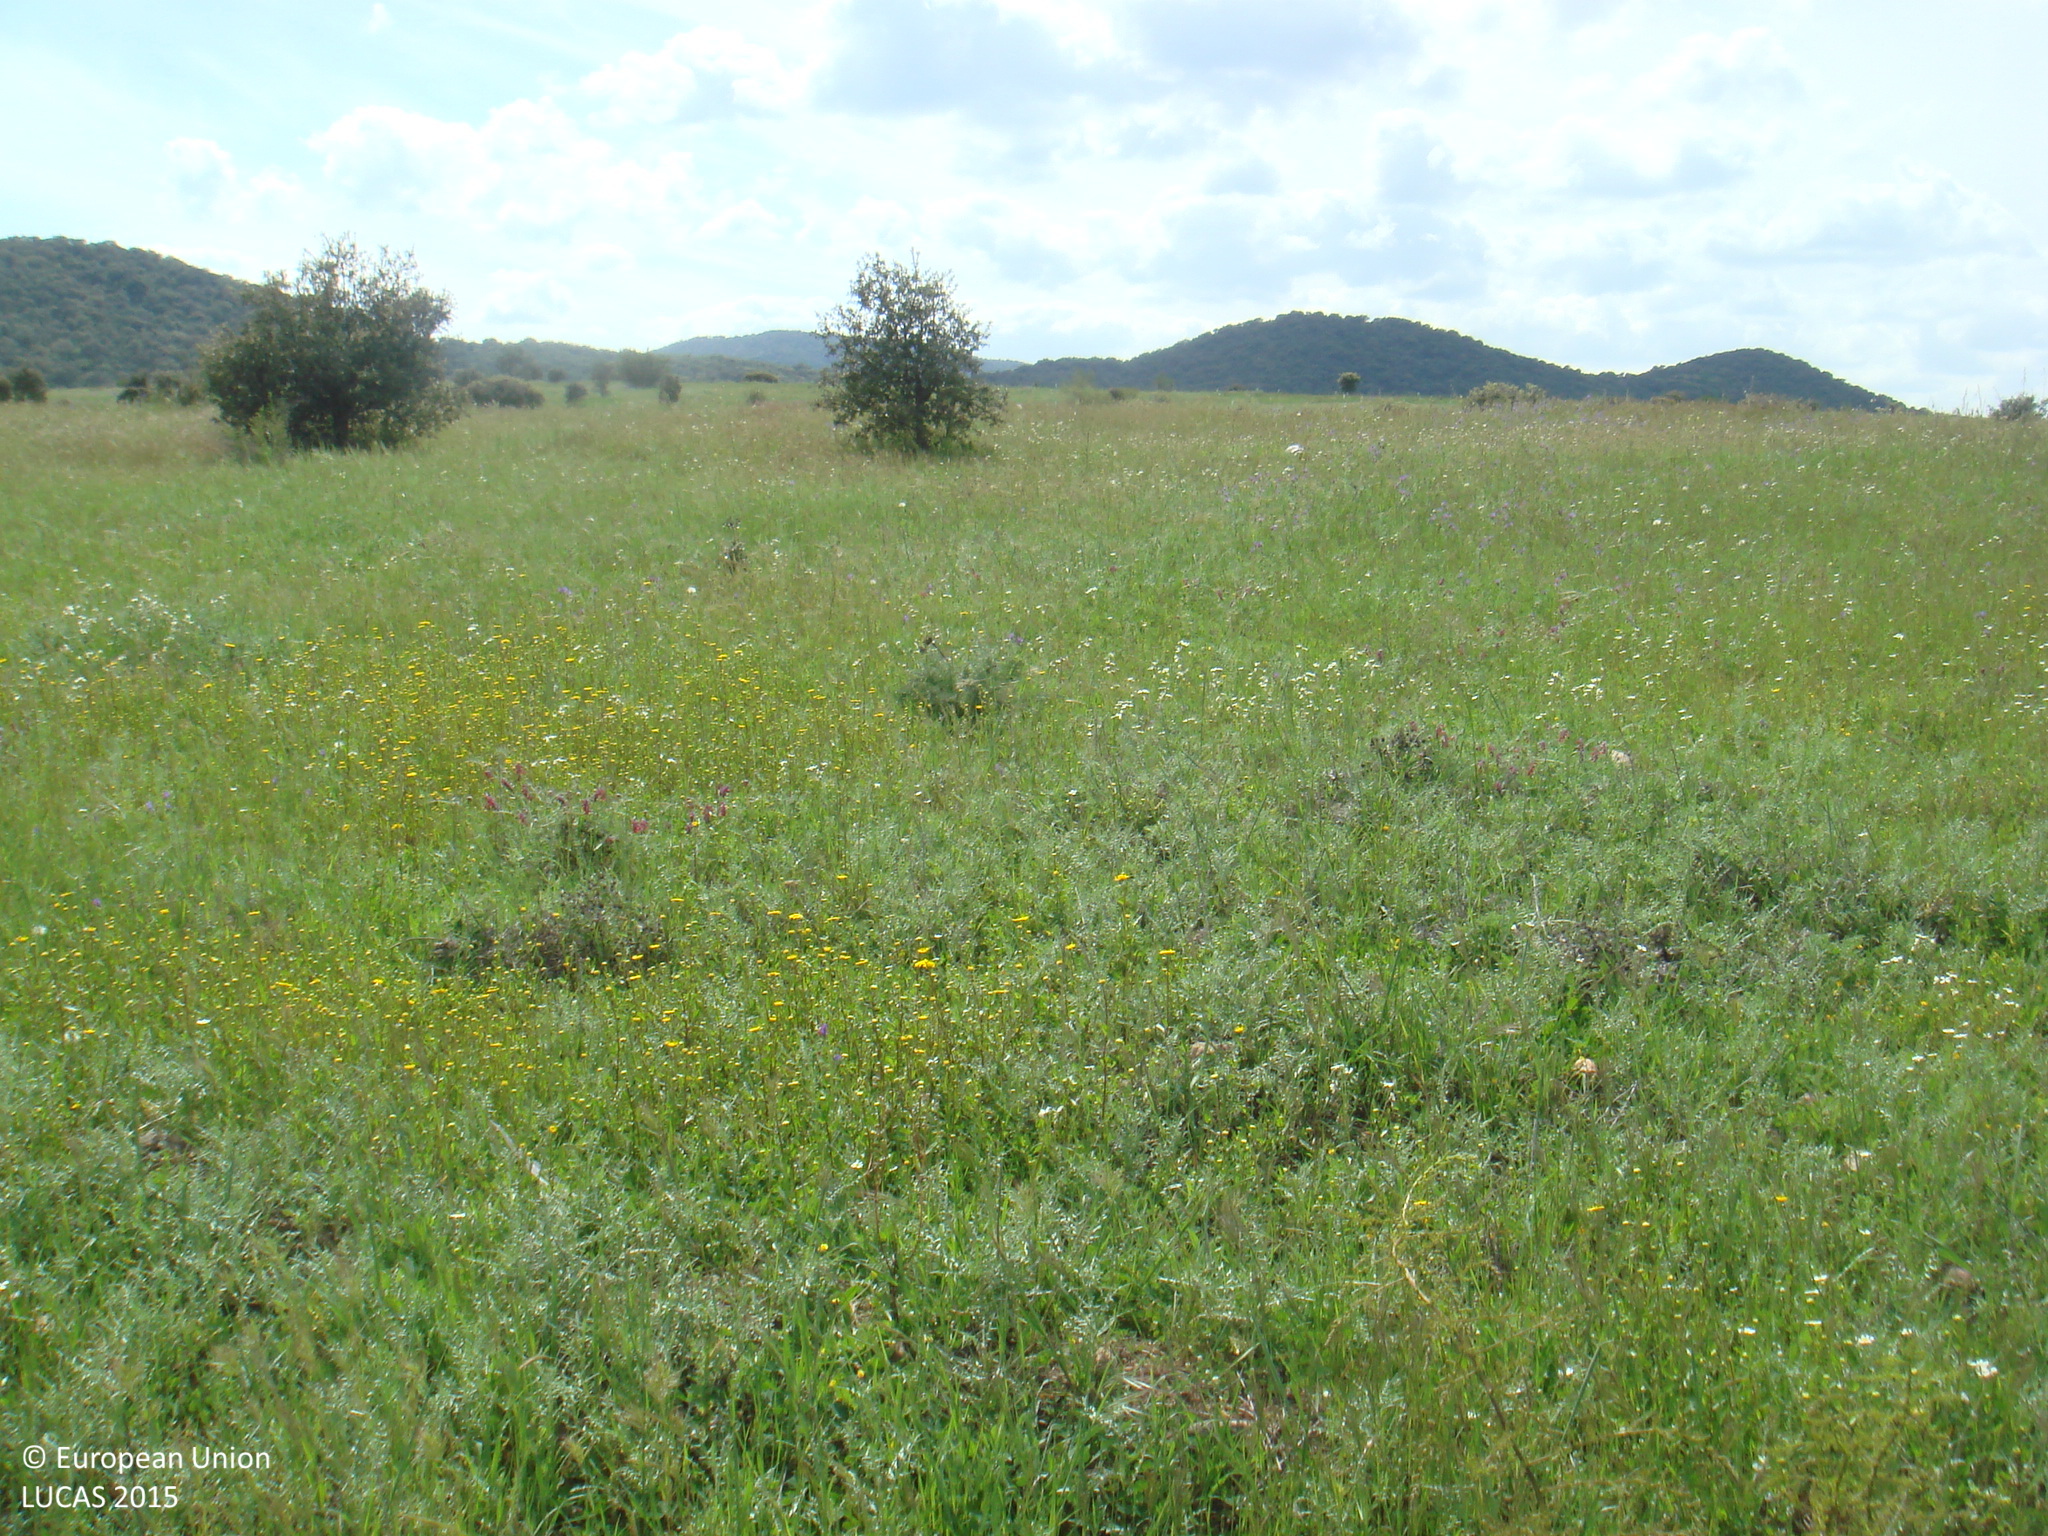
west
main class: Grassland
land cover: Grassland without tree/shrub cover
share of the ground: > 75 %
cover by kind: herbaceous plants 95 %, shrubs 5 %
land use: Agriculture (excluding fallow land and kitchen gardens)
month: April
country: ES
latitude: 38.1965
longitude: -5.0618
